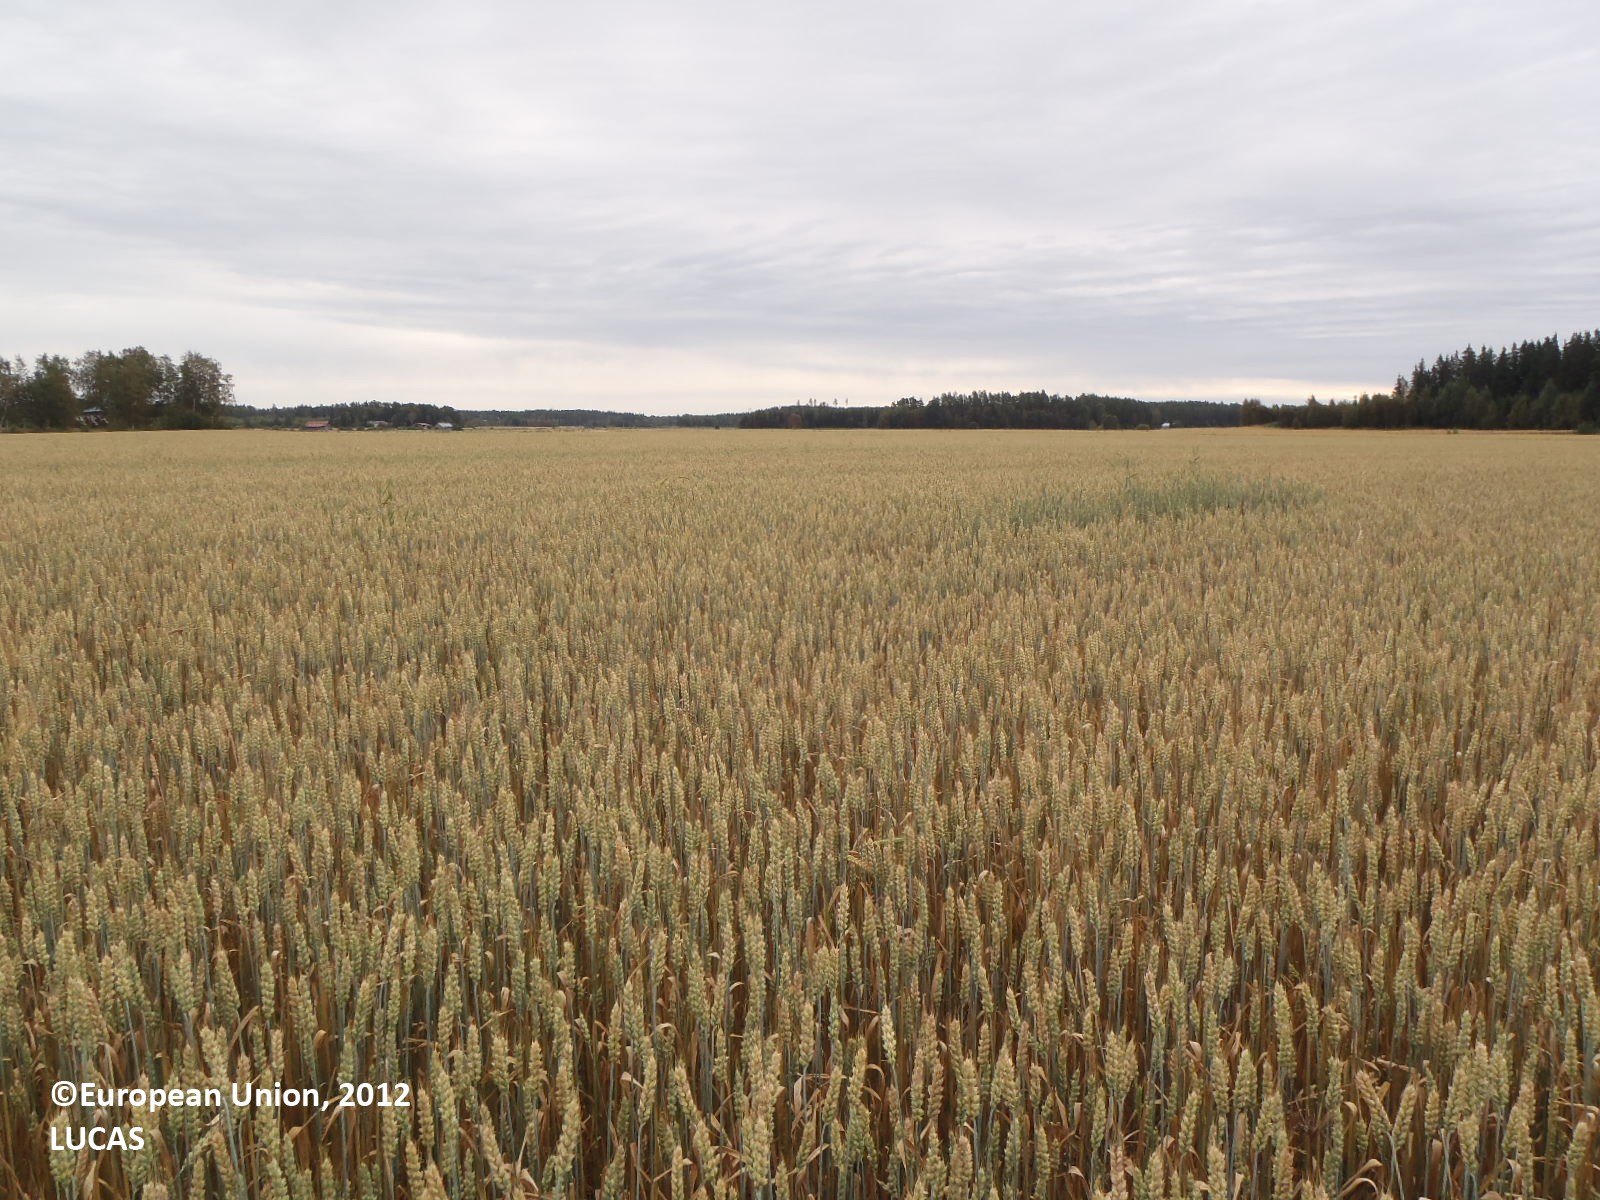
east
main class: Cropland
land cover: Common wheat
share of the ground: > 75 %
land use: Agriculture (excluding fallow land and kitchen gardens)
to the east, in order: Common wheat; Grass margins; Ditches and canals; Abandoned hedges; Grass margins; Barley
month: August
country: FI
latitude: 60.8697
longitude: 21.7887
